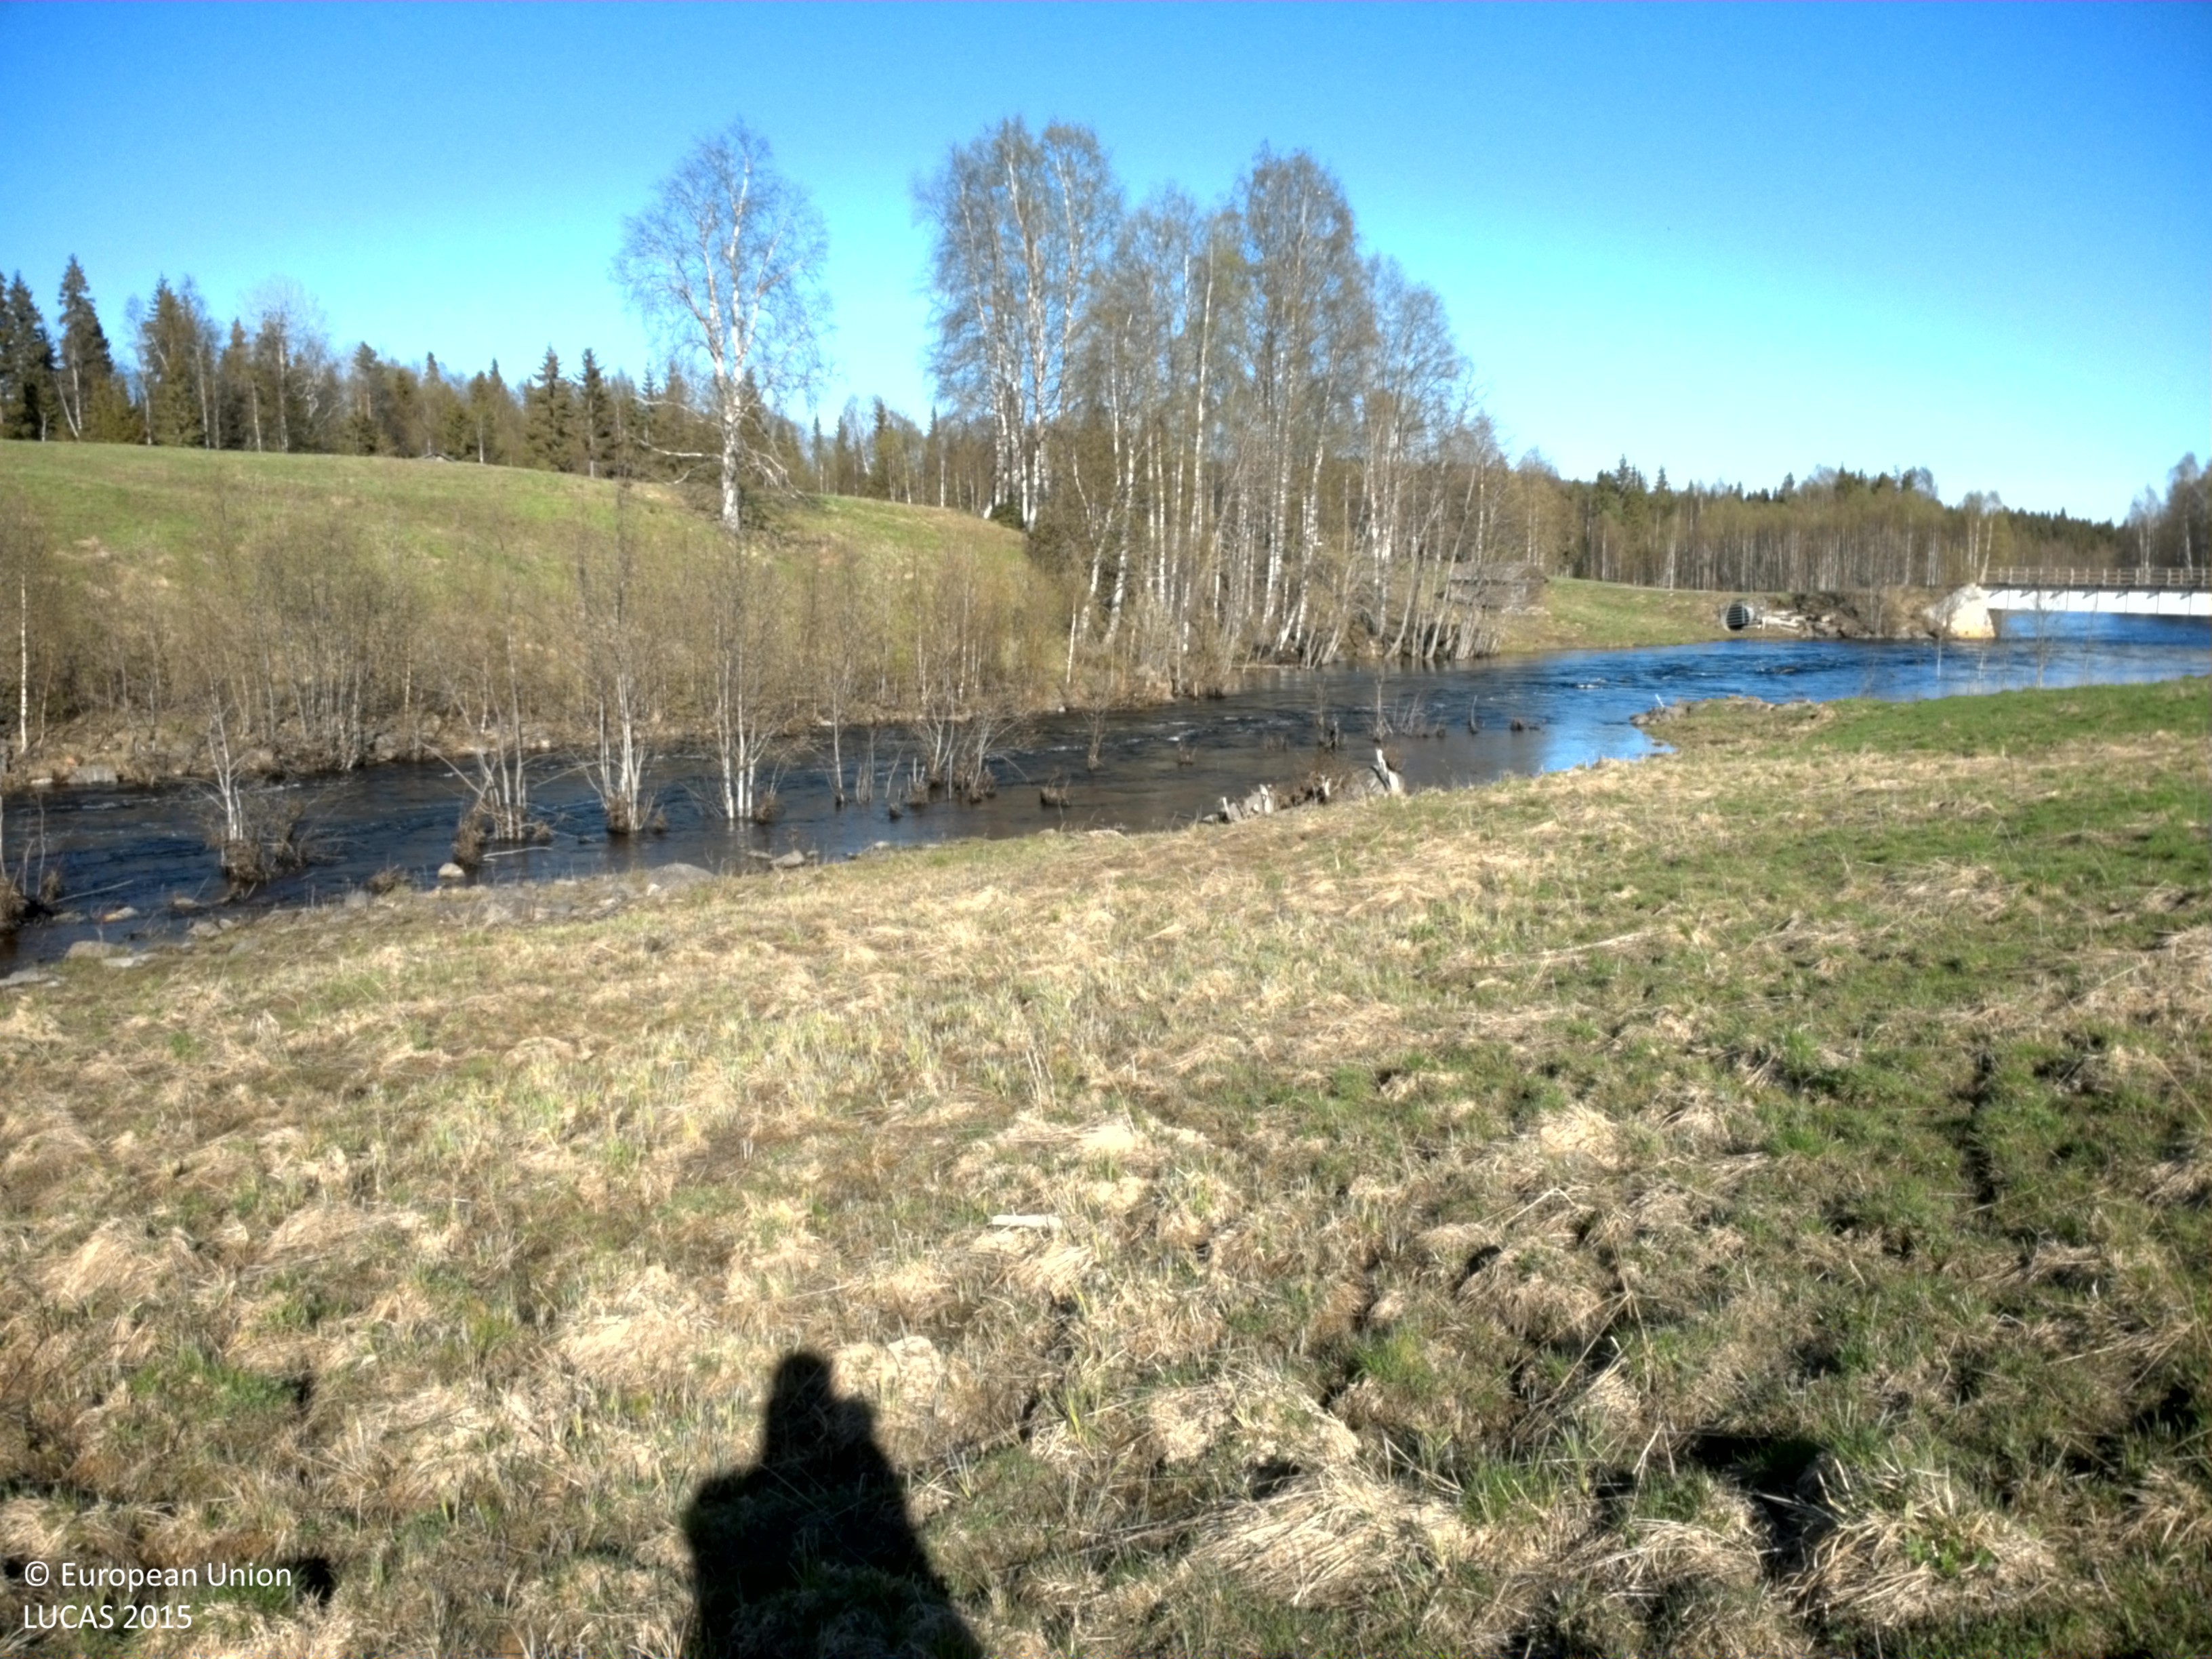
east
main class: Grassland
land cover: Grassland without tree/shrub cover
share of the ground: > 75 %
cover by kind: herbaceous plants 100 %
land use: Agriculture (excluding fallow land and kitchen gardens)
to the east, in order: Grassland without tree/shrub cover; Groves; Rivers and streams; Groves; Grassland without tree/shrub cover; Broadleaved woodland; Grassland without tree/shrub cover; Tracks; Grass margins; Spruce dominated mixed woodland; Rivers and streams; Spruce dominated mixed woodland
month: May
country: SE
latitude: 66.0918
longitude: 23.3661
